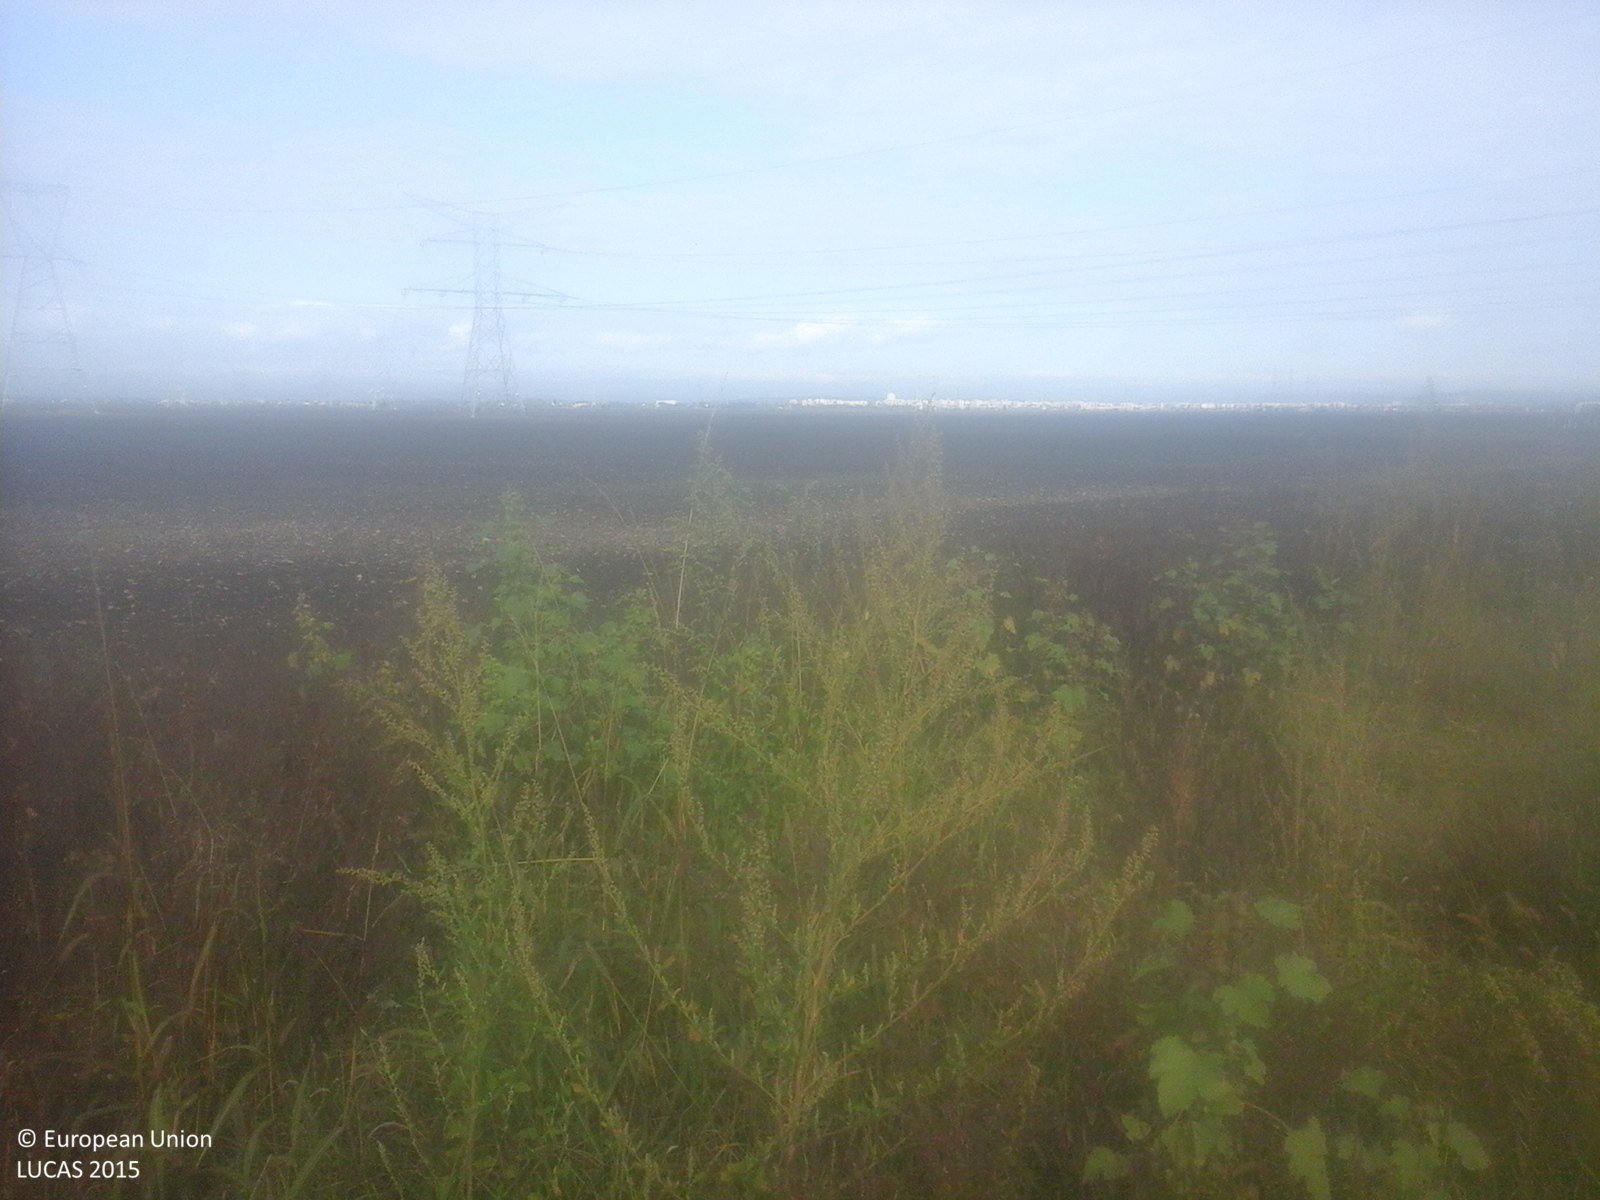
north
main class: Grassland
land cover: Spontaneously vegetated surfaces
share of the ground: > 75 %
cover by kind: herbaceous plants 100 %
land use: Fallow land
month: October
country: RO
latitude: 44.8807
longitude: 25.9948
